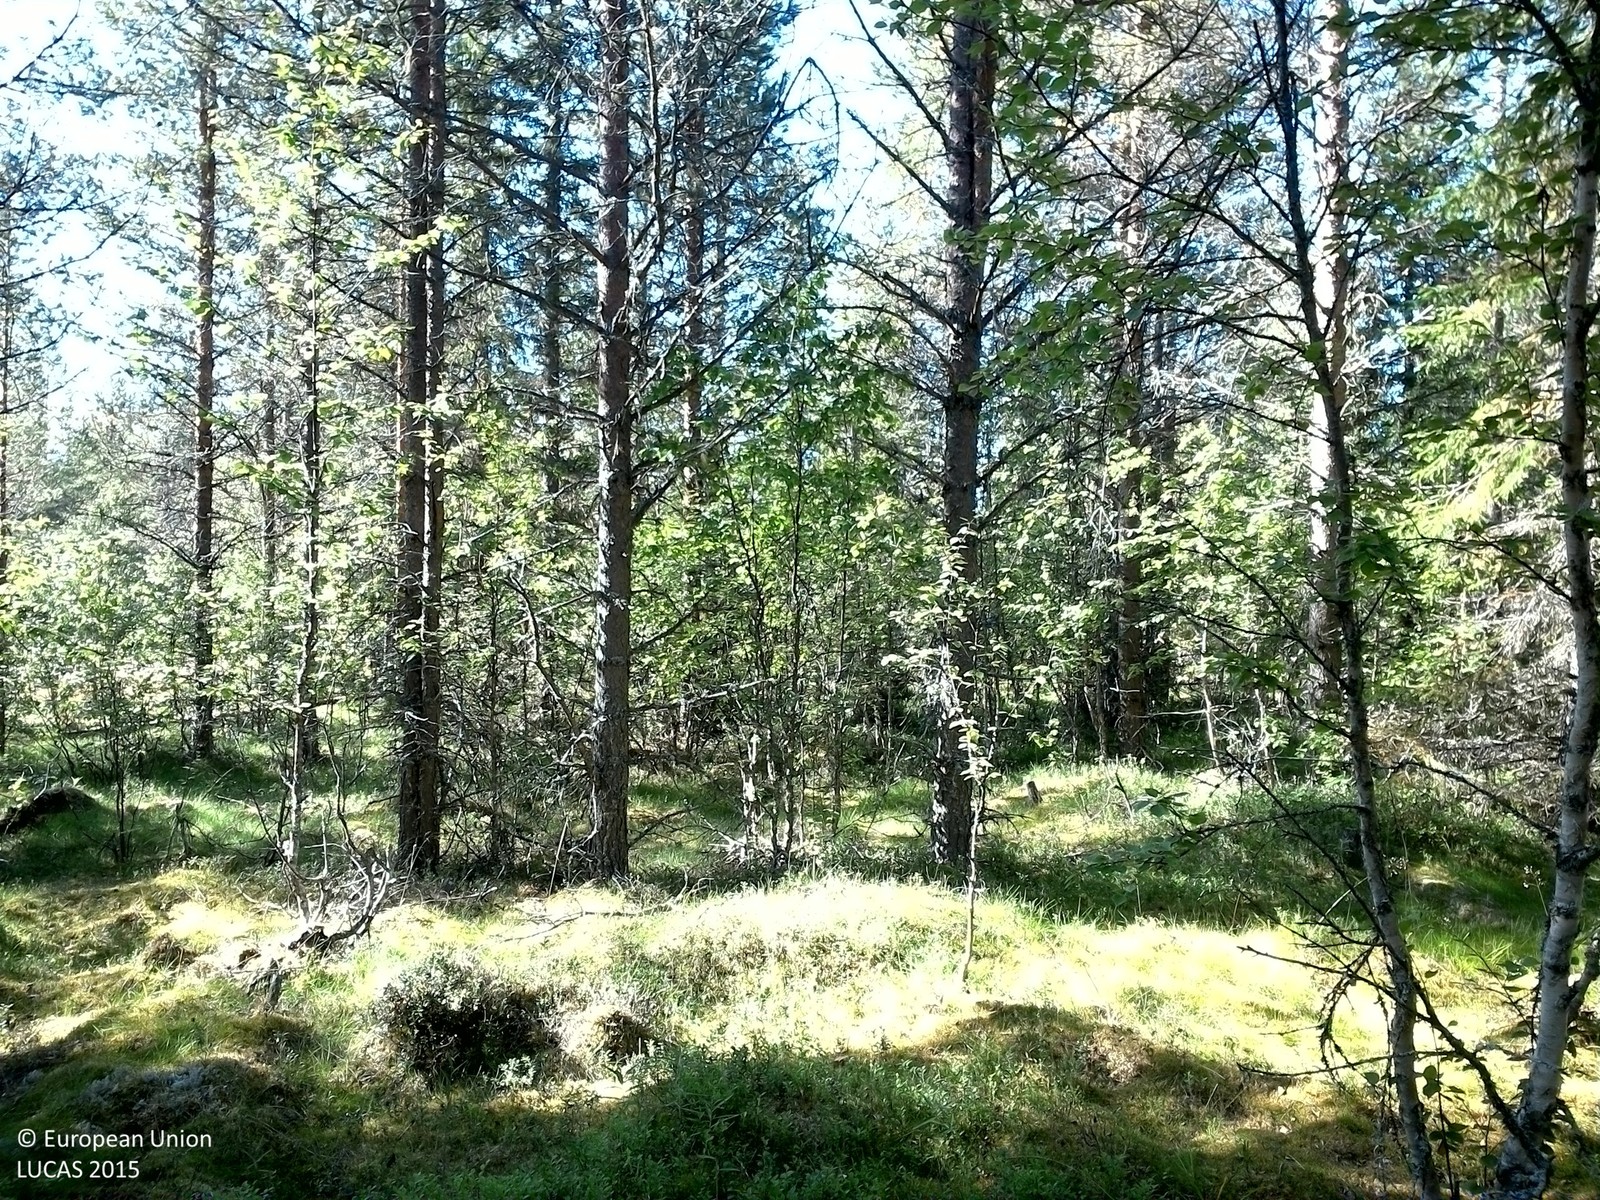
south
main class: Woodland
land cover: Pine dominated coniferous woodland
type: boreal forest
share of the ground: 50 - 75 %
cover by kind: coniferous forest trees 65 %, broadleaved forest trees 10 %, shrubs 10 %, lichens and mosses 10 %, herbaceous plants 5 %
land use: Forestry
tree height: > 5 m
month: August
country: SE
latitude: 63.7235
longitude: 18.0109
